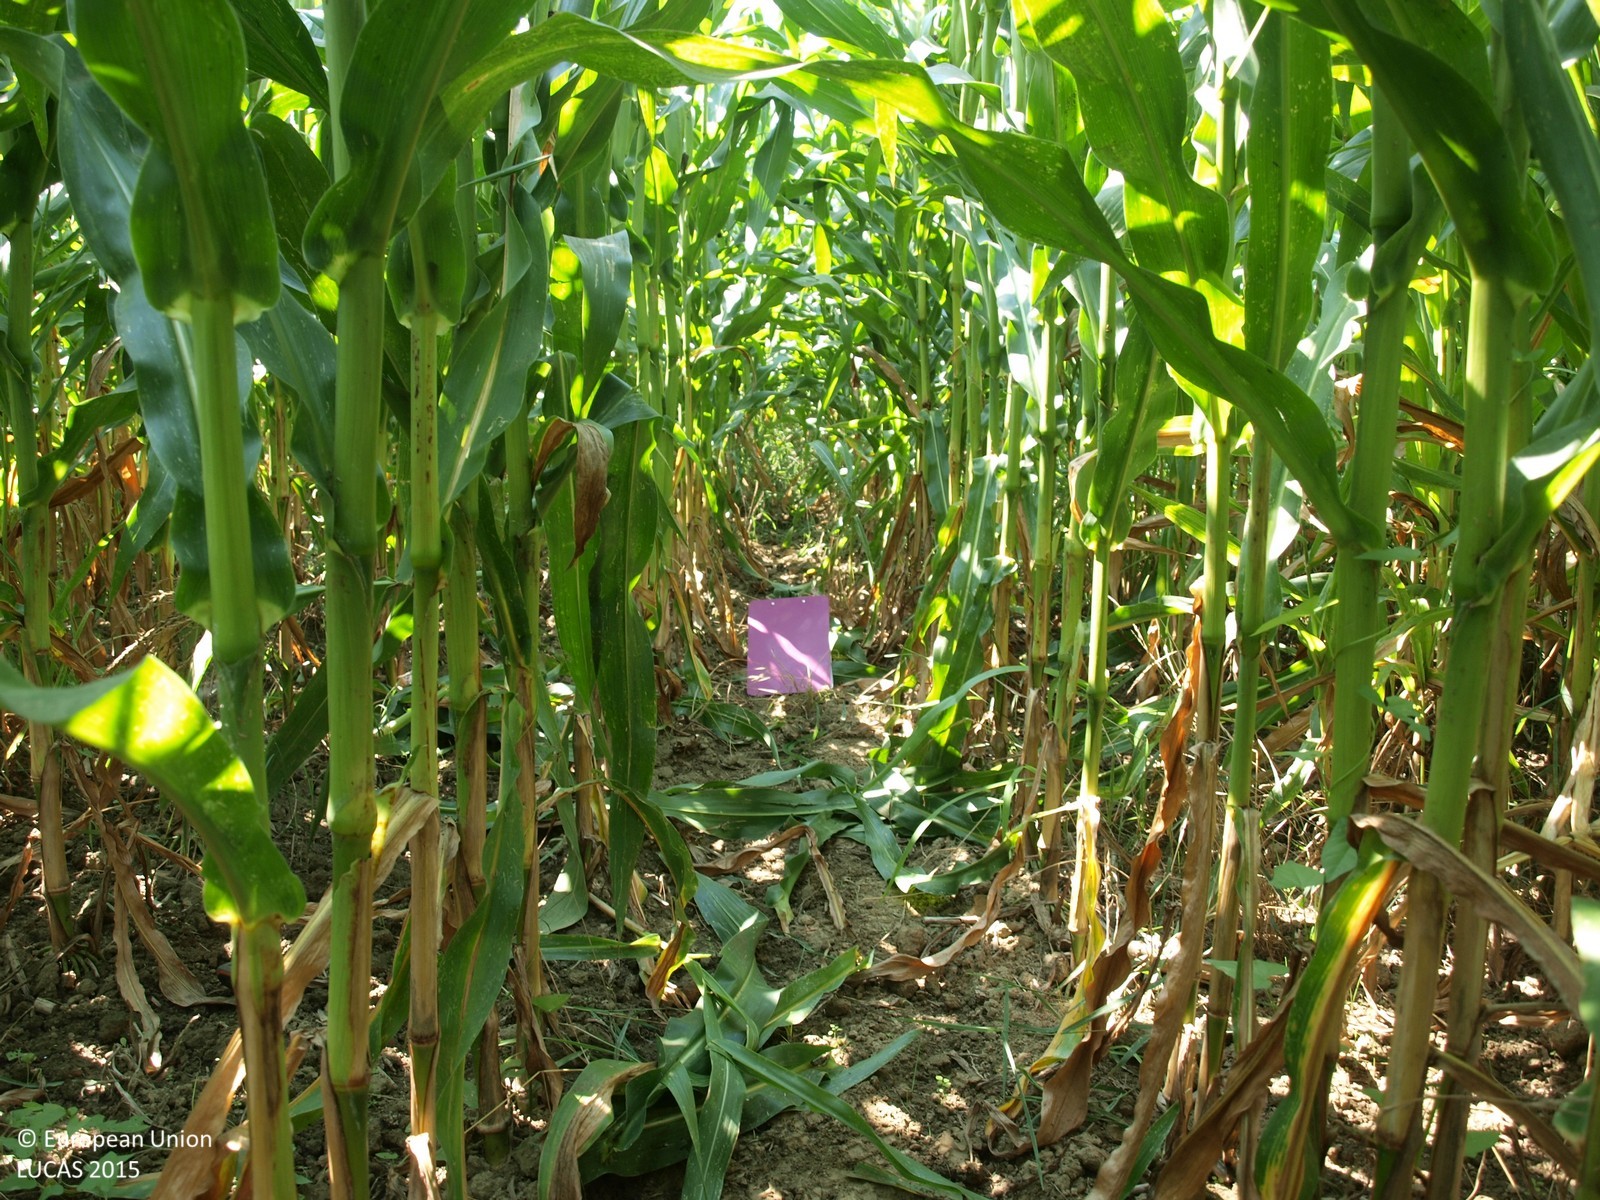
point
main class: Cropland
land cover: Maize
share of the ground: > 75 %
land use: Agriculture (excluding fallow land and kitchen gardens)
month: August
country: HR
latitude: 45.9263
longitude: 16.6669
